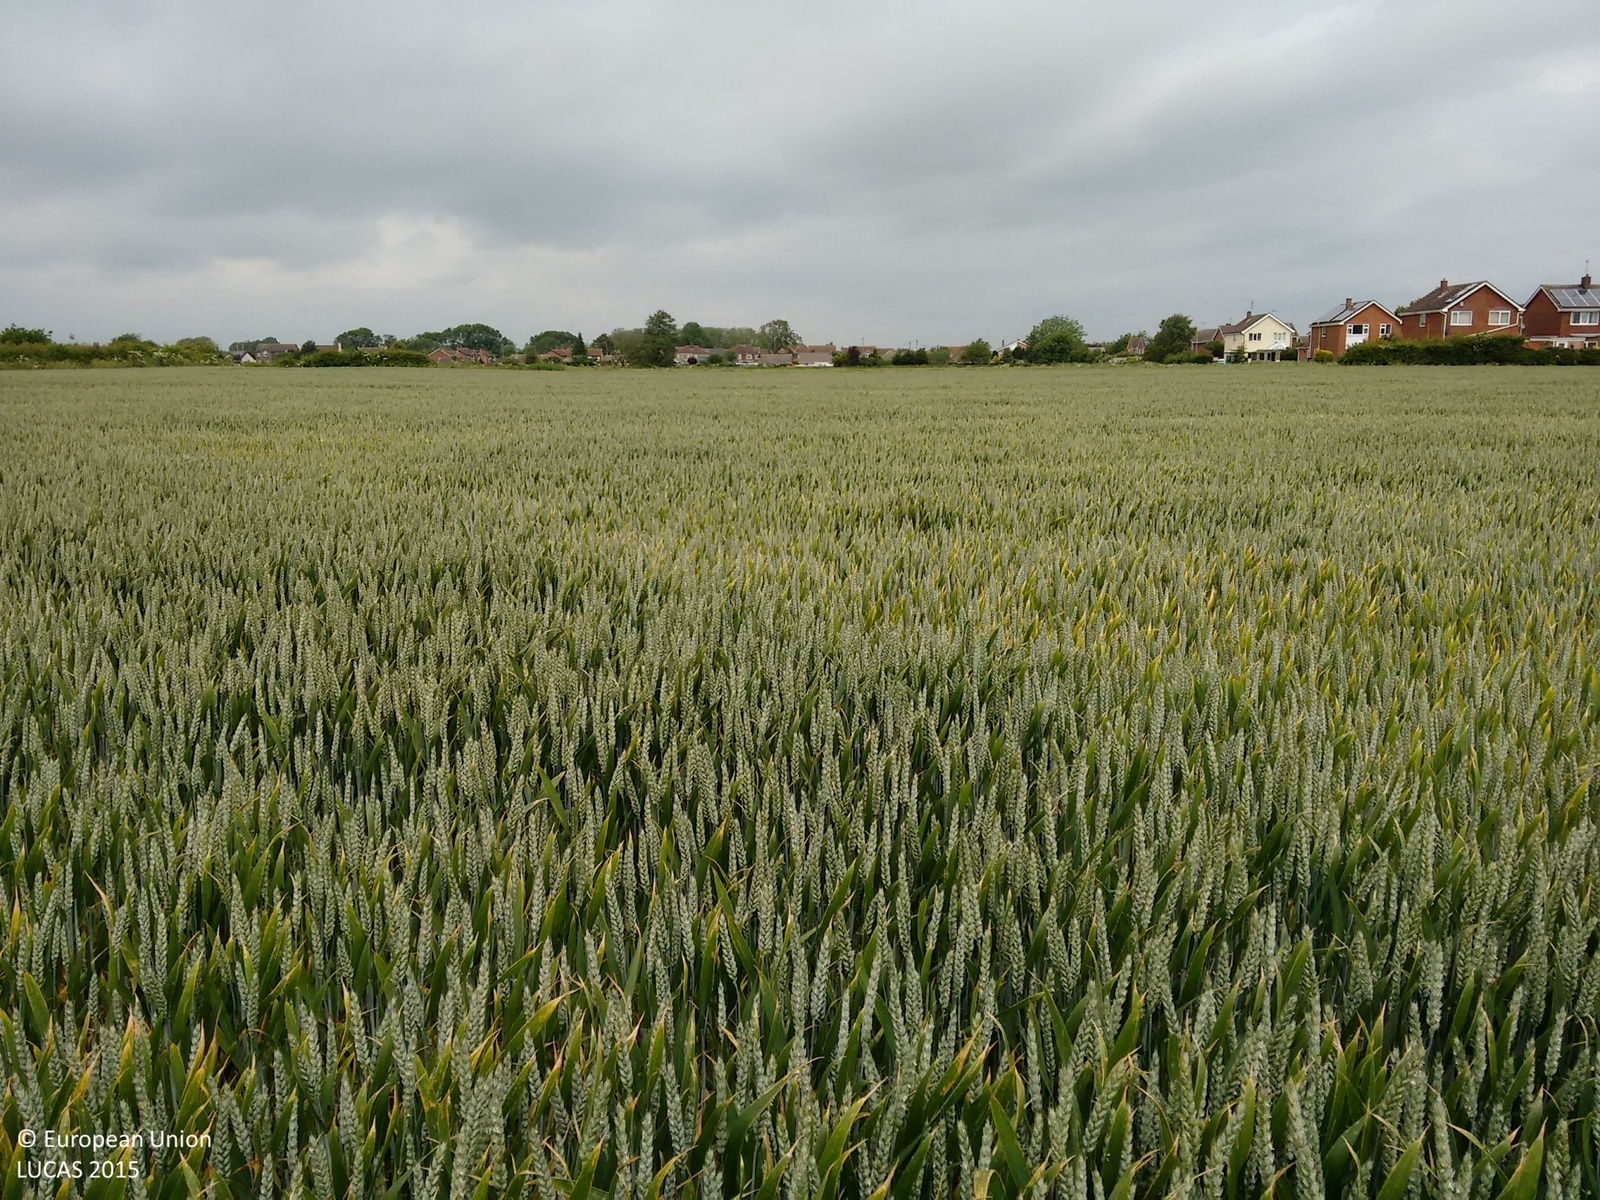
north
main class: Cropland
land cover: Common wheat
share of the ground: > 75 %
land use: Agriculture (excluding fallow land and kitchen gardens)
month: June
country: GB
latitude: 53.0433
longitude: -0.4029
